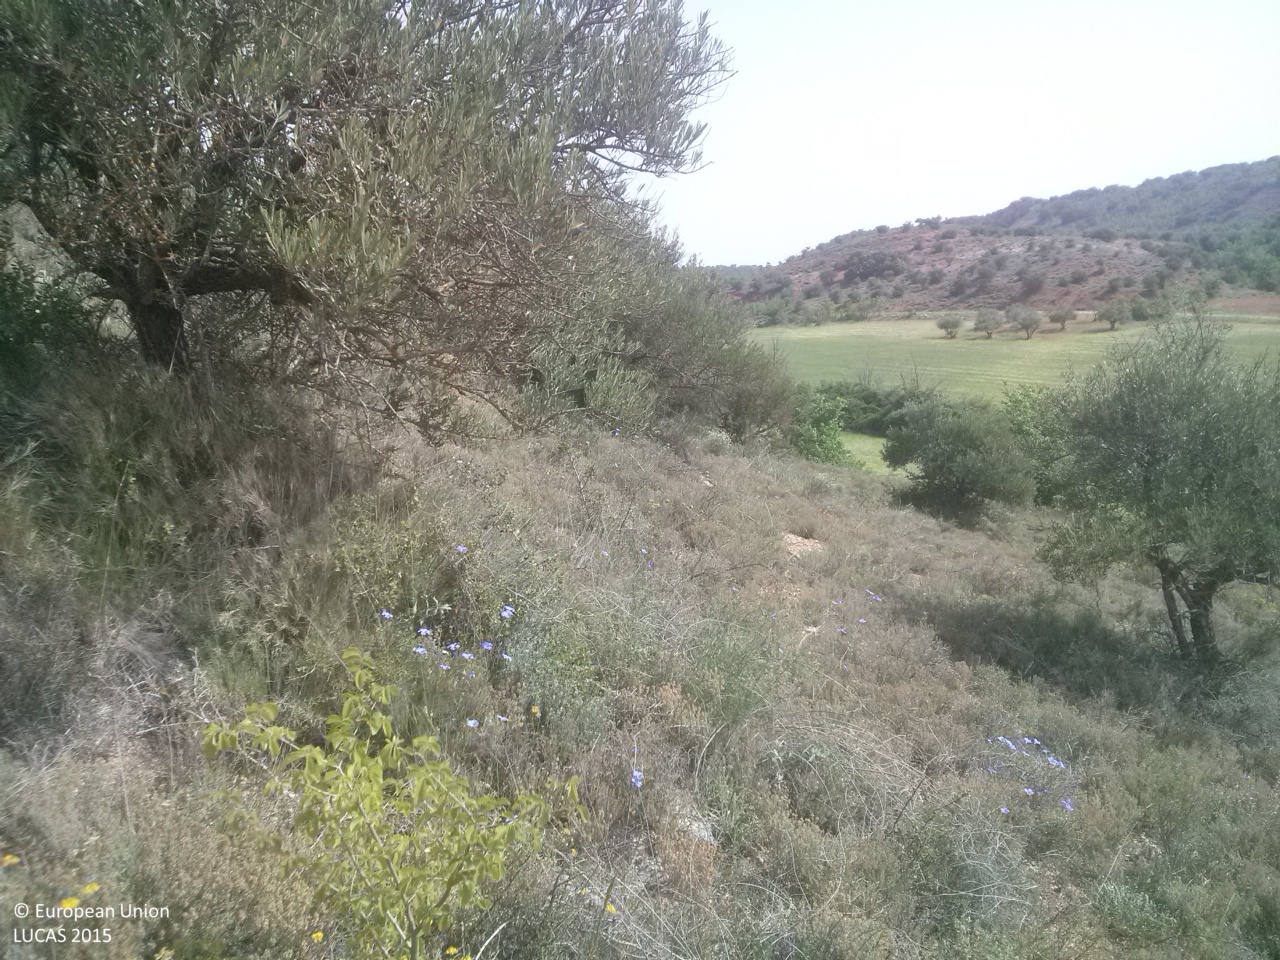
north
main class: Cropland
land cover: Olive groves
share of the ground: 10 - 25 %
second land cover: Shrubland without tree cover
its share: > 75 %
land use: Abandoned areas
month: May
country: ES
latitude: 39.9720
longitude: -2.5347
